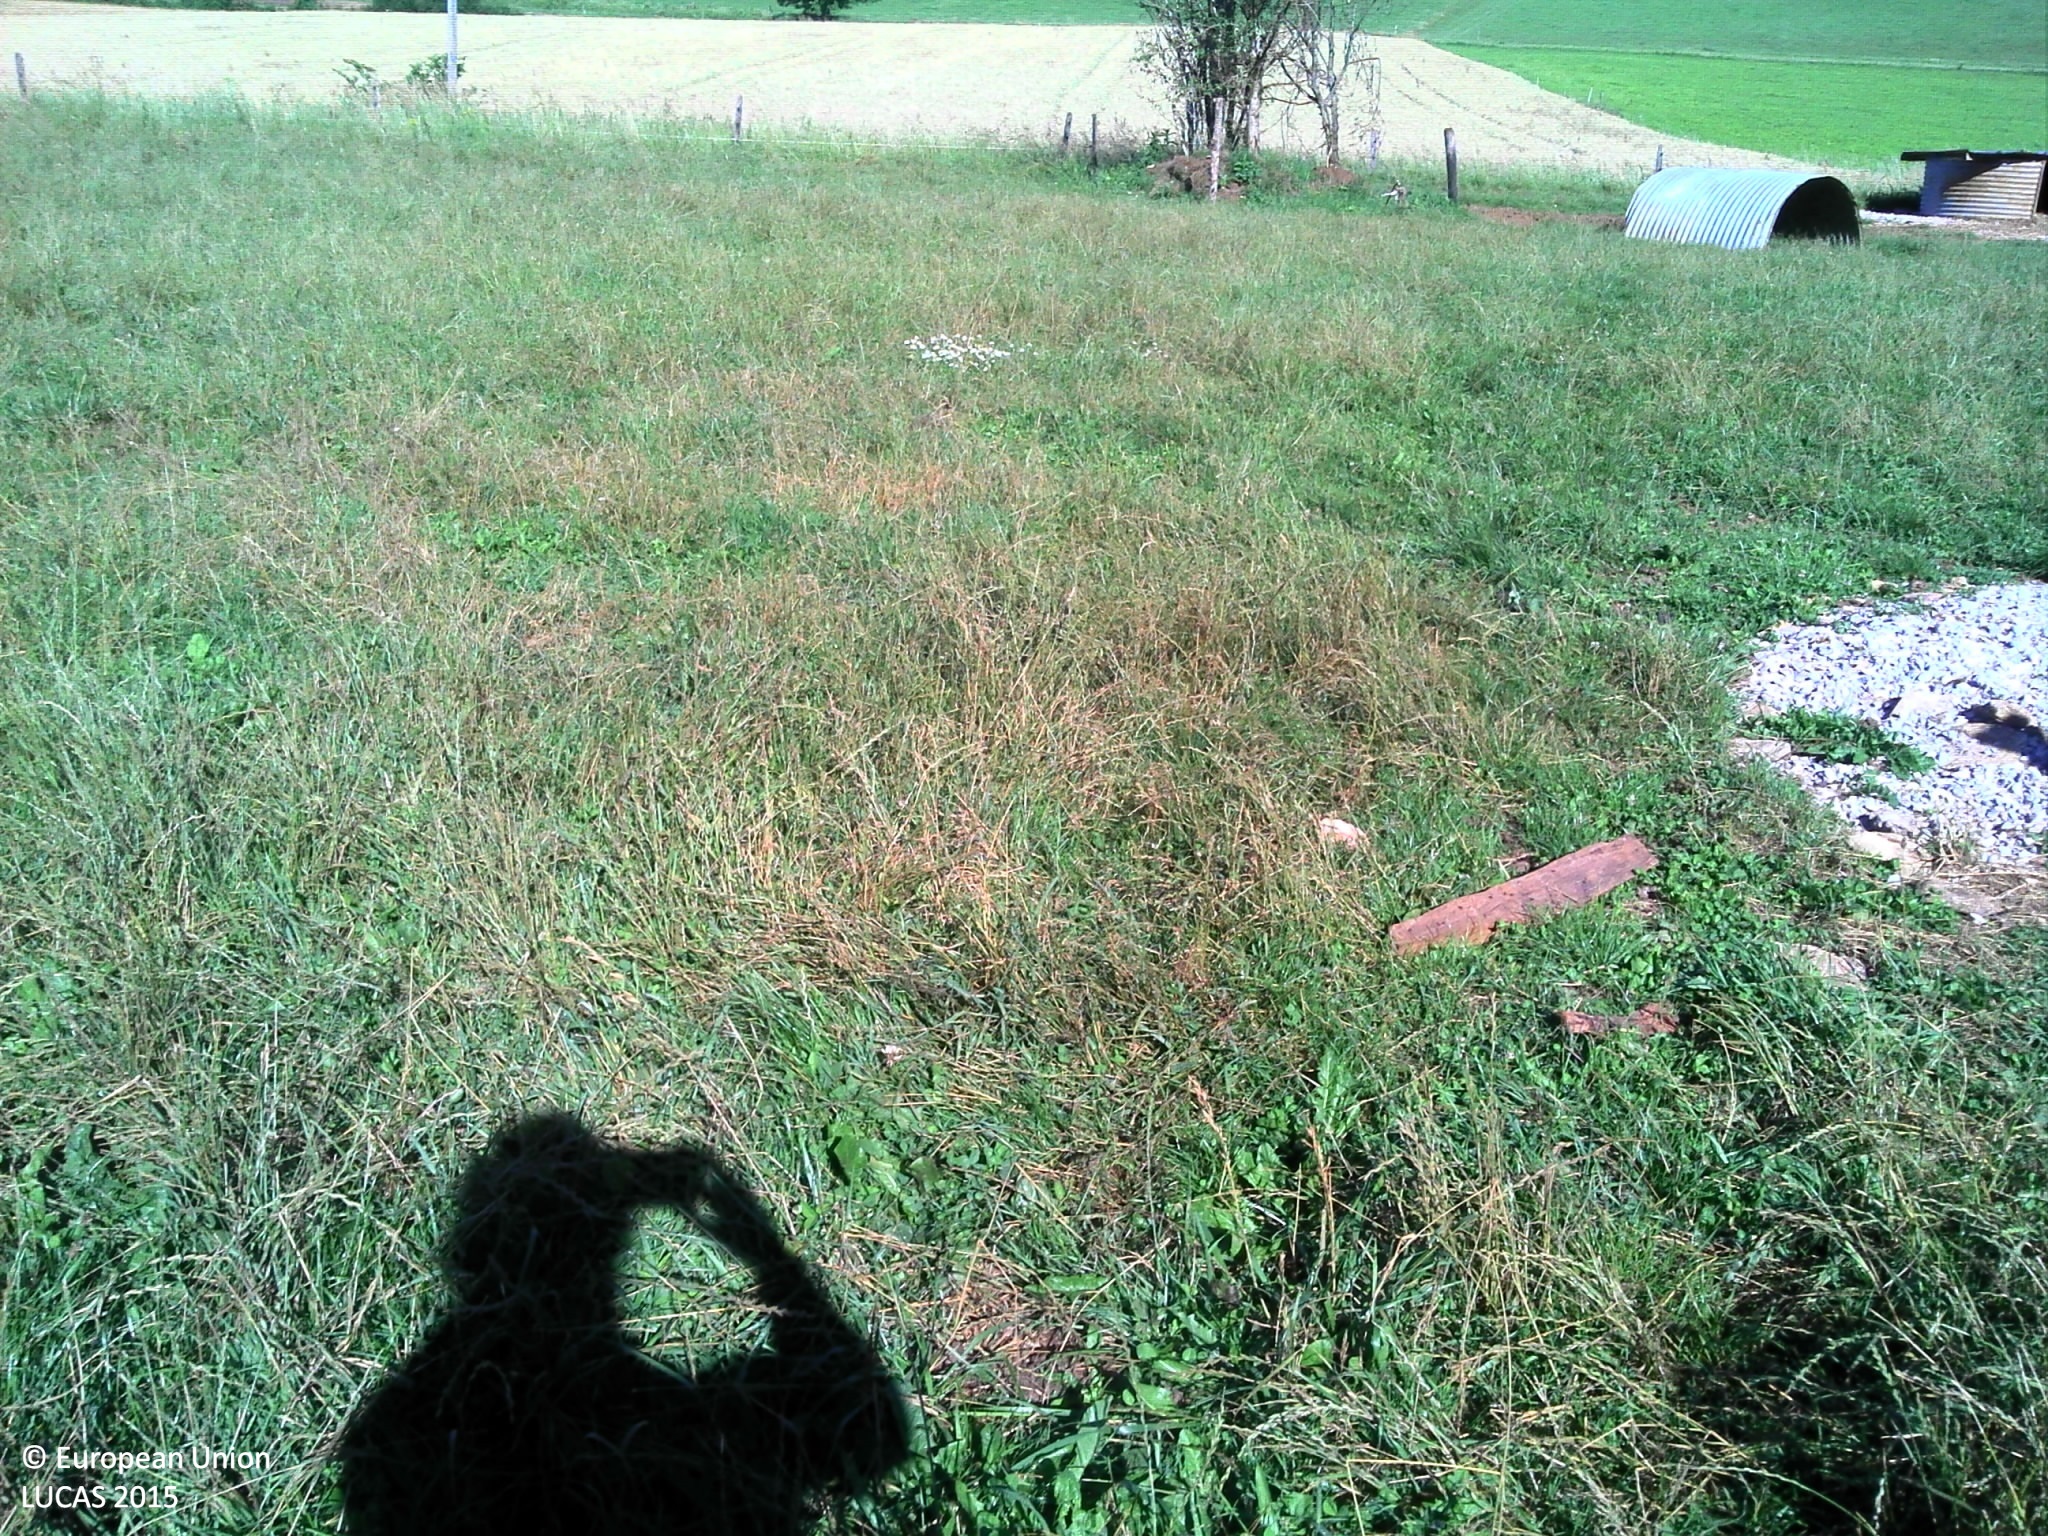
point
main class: Grassland
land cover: Grassland without tree/shrub cover
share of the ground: > 75 %
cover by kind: herbaceous plants 100 %
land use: Agriculture (excluding fallow land and kitchen gardens)
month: June
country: FR
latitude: 46.5093
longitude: 5.5064
